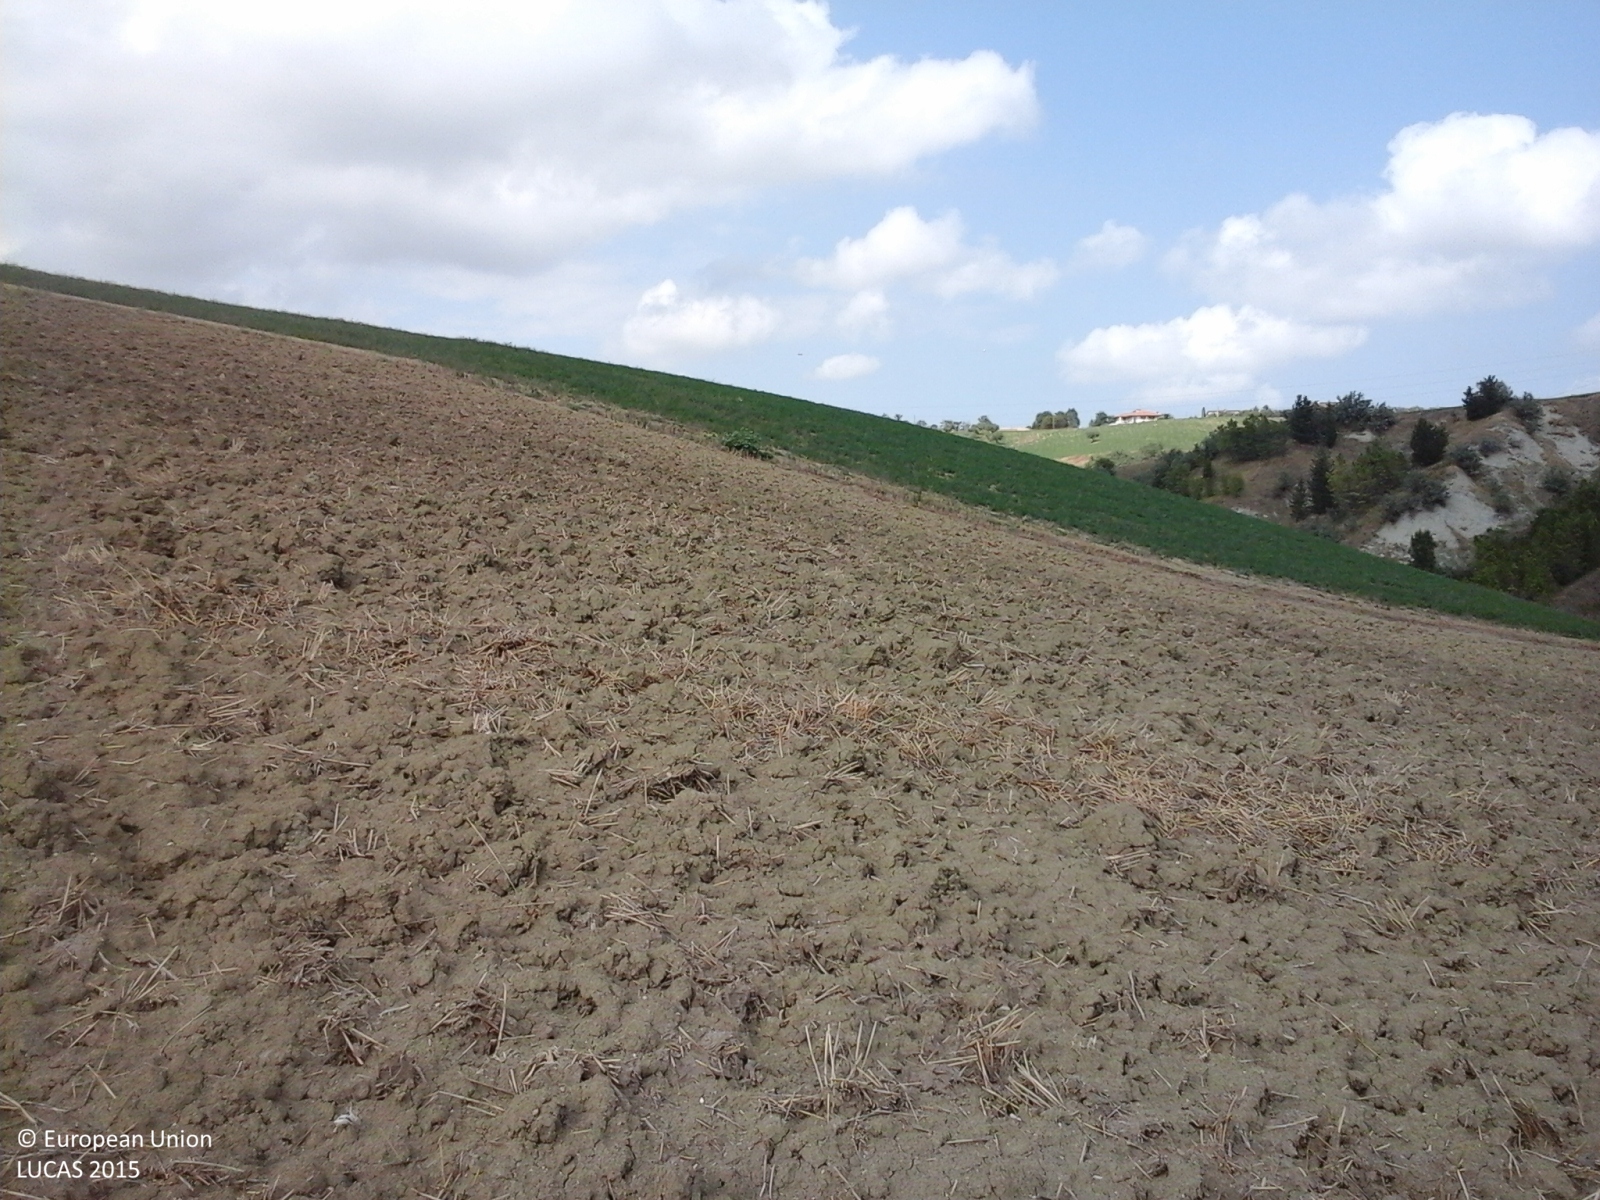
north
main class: Cropland
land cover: Durum wheat
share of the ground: < 10 %
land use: Agriculture (excluding fallow land and kitchen gardens)
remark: Harvested field
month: August
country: IT
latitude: 42.7287
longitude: 13.7630
